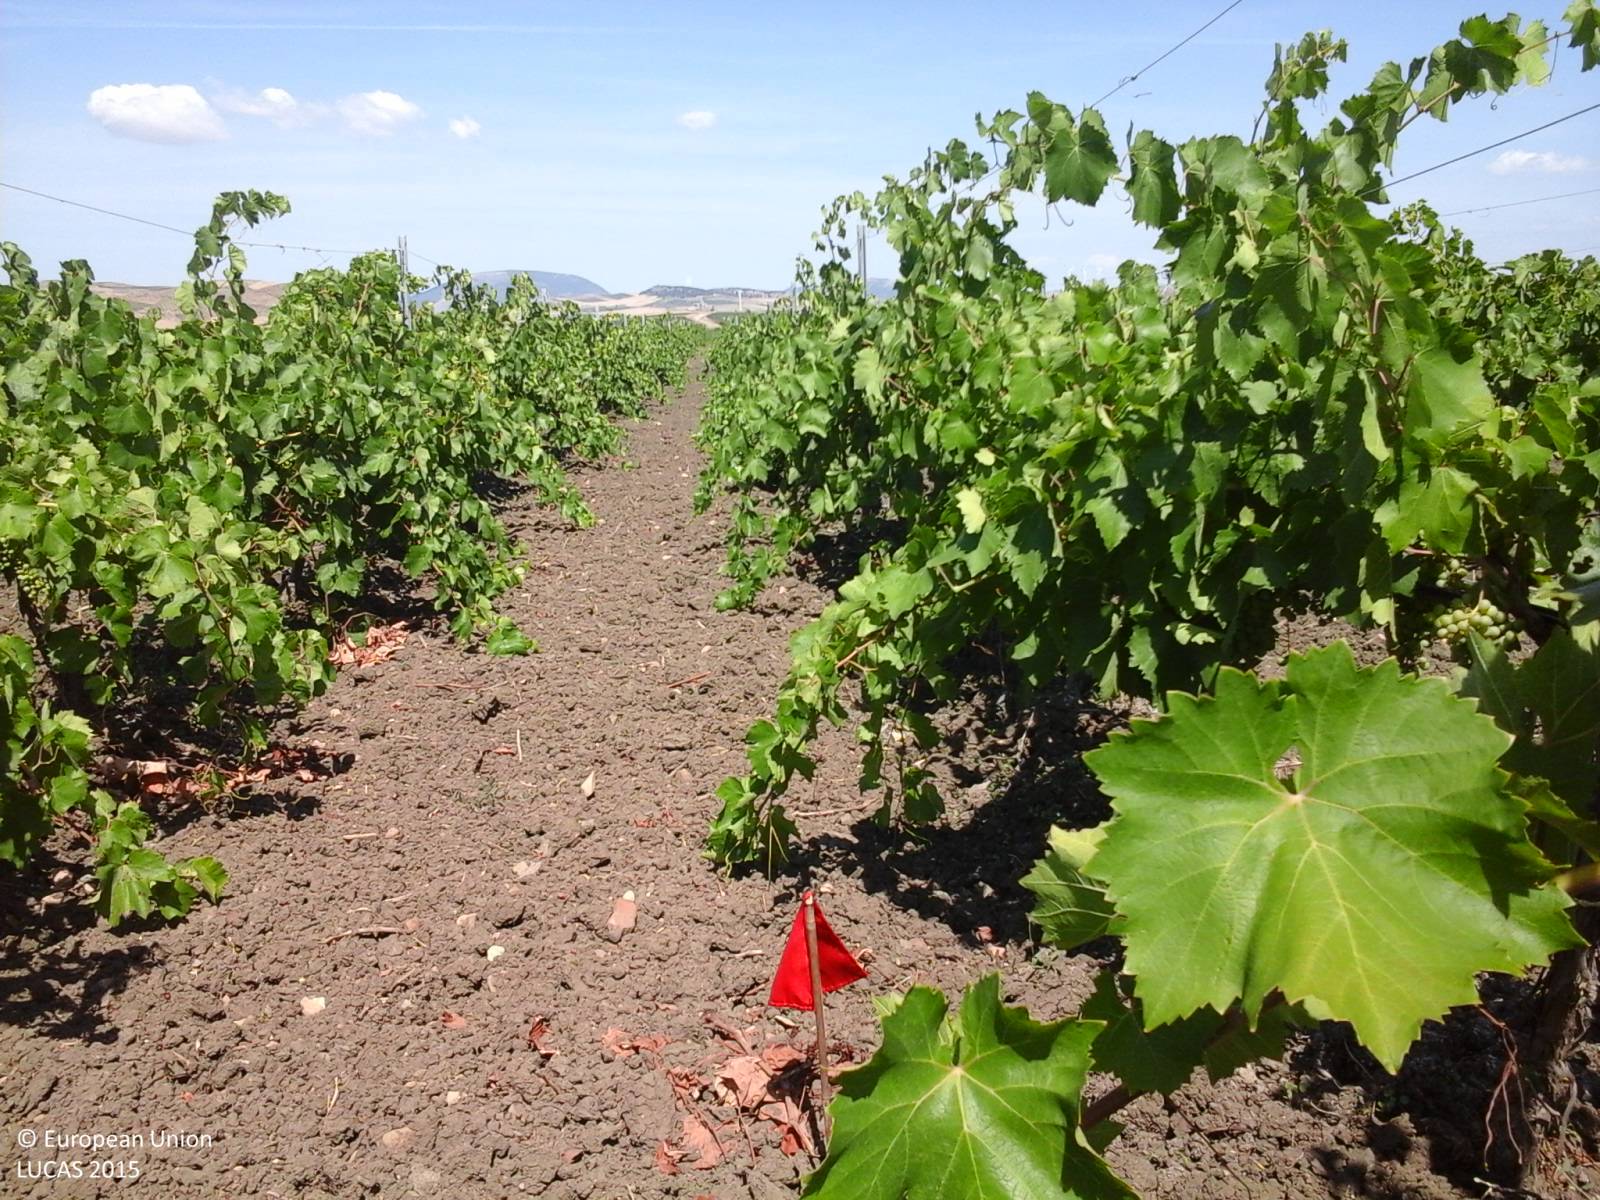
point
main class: Cropland
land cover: Vineyards
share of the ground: 25 - 50 %
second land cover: Other bare soil
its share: > 75 %
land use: Agriculture (excluding fallow land and kitchen gardens)
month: June
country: IT
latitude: 37.8396
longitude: 12.5830
